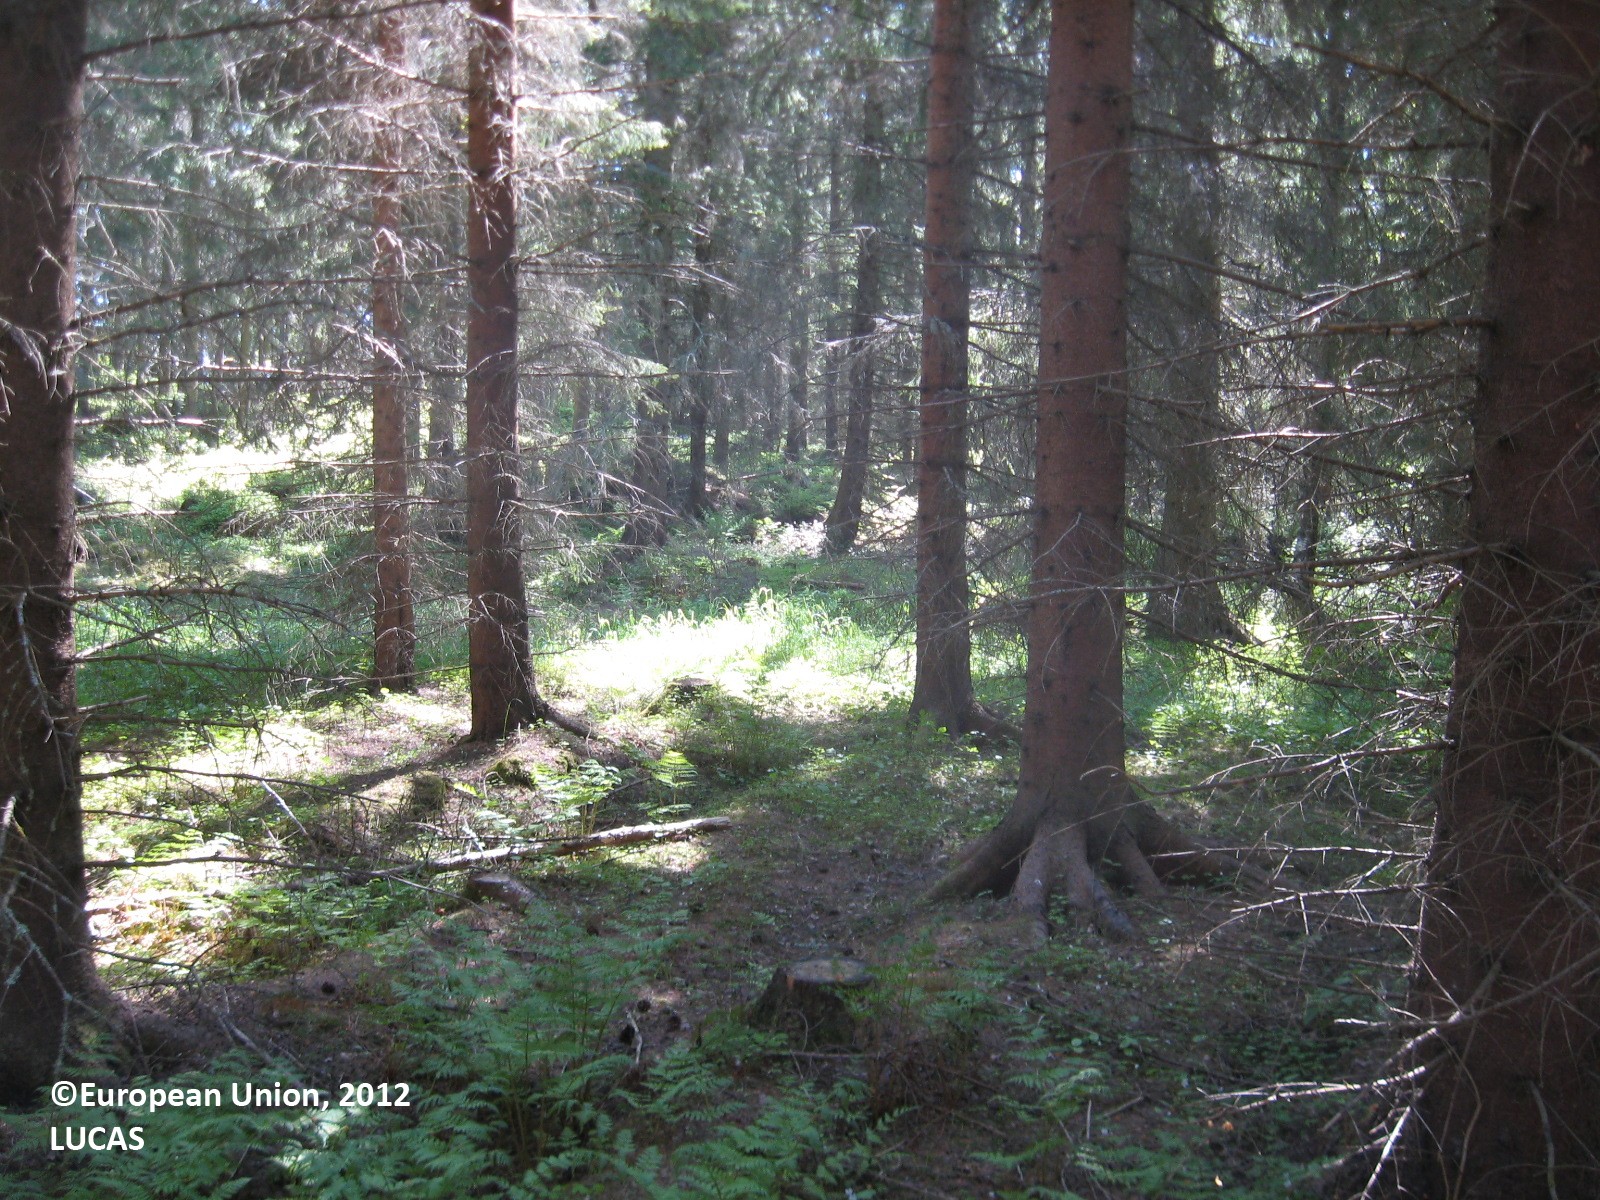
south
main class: Woodland
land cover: Spruce dominated coniferous woodland
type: boreal forest
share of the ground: > 75 %
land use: Forestry
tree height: > 5 m
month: June
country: FI
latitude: 63.2279
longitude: 21.7610
